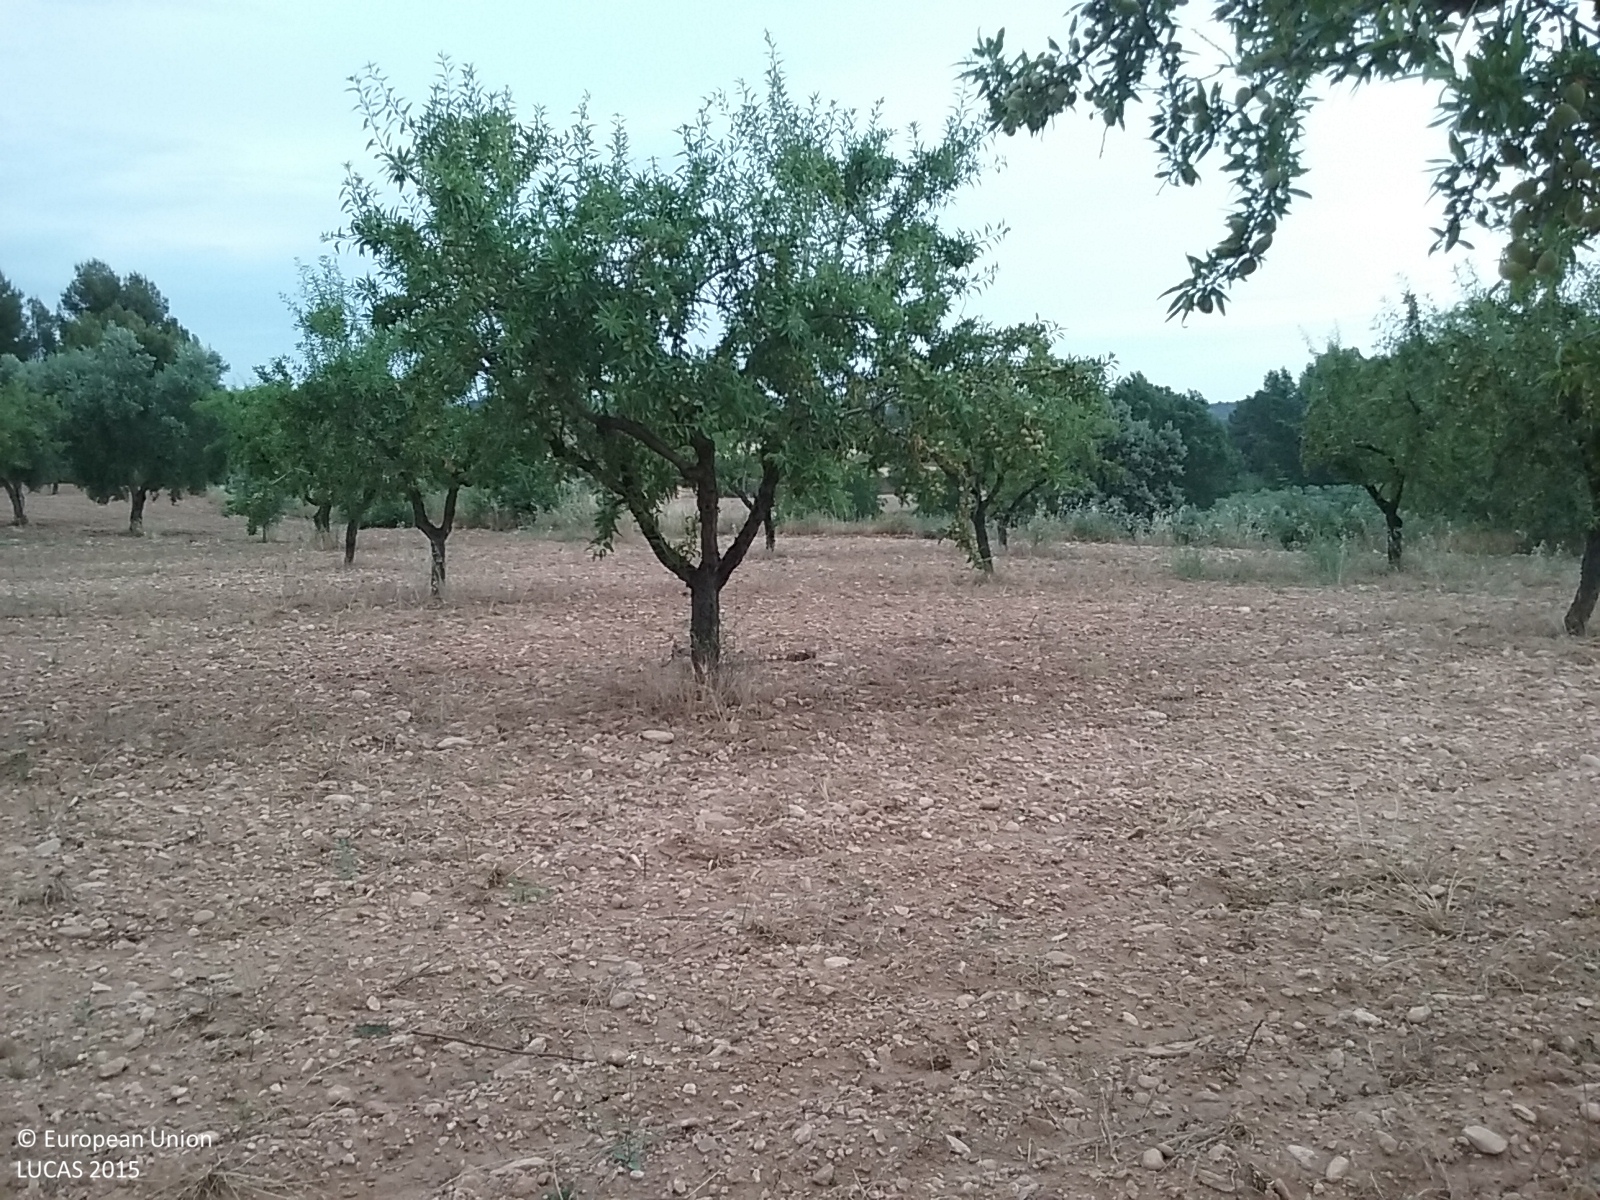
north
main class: Cropland
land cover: Nuts trees
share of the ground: 25 - 50 %
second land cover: Other bare soil
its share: > 75 %
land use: Agriculture (excluding fallow land and kitchen gardens)
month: June
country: ES
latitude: 40.9089
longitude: 0.2448
